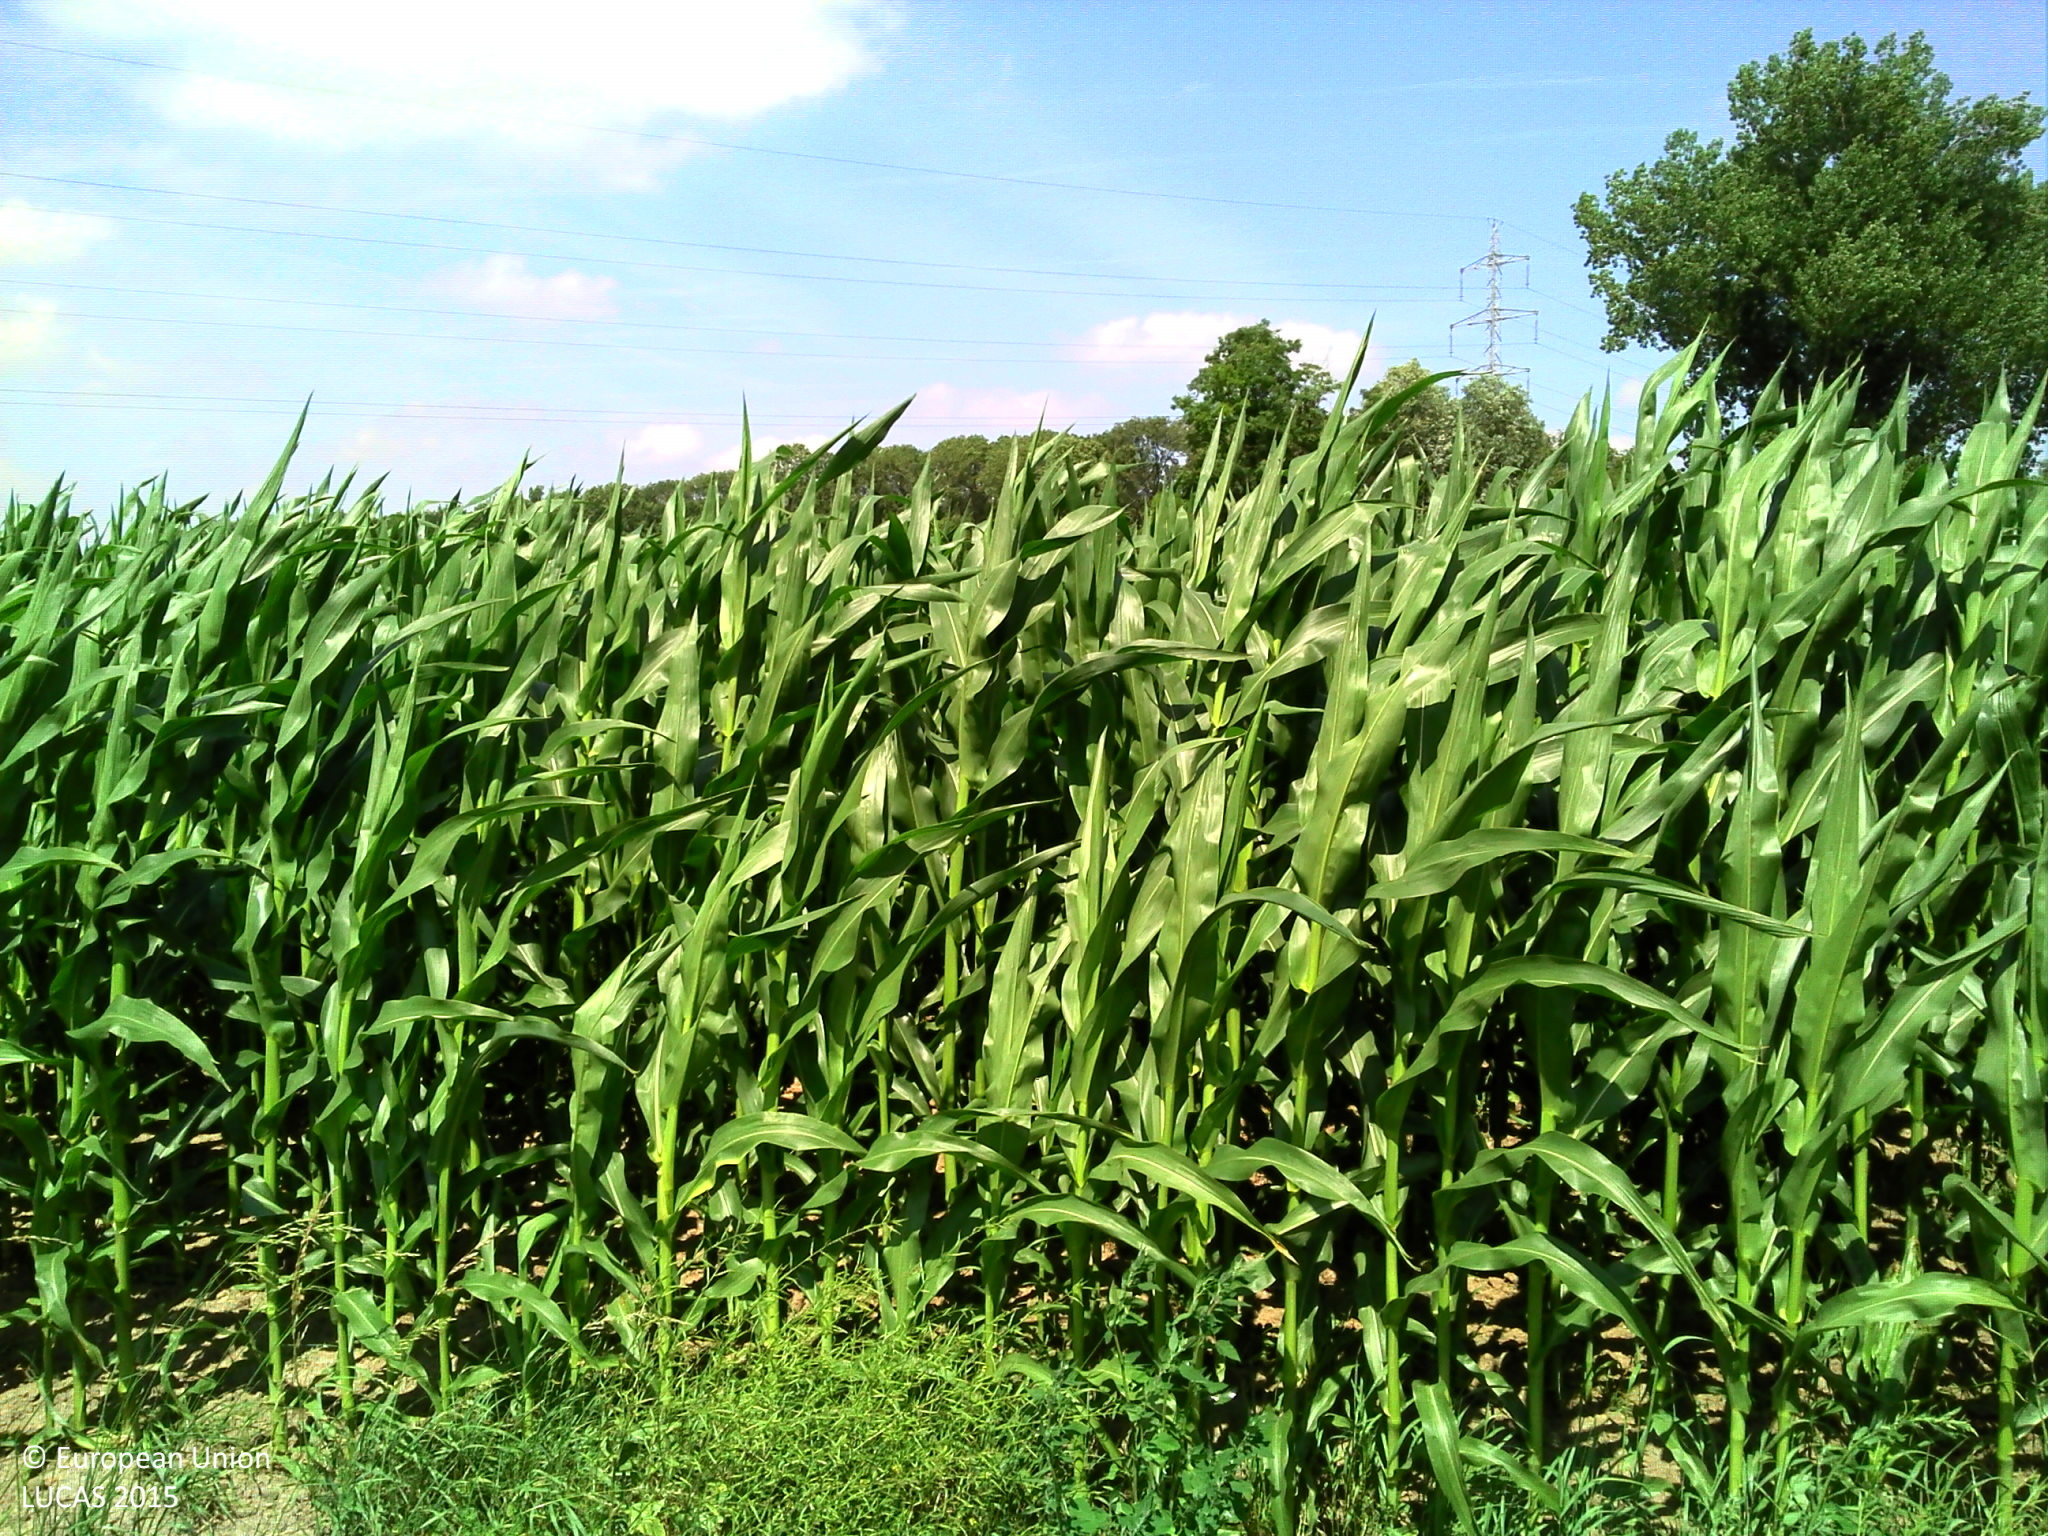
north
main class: Grassland
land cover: Grassland without tree/shrub cover
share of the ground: > 75 %
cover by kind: herbaceous plants 100 %
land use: Agriculture (excluding fallow land and kitchen gardens)
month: July
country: BE
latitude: 50.4473
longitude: 4.1222
